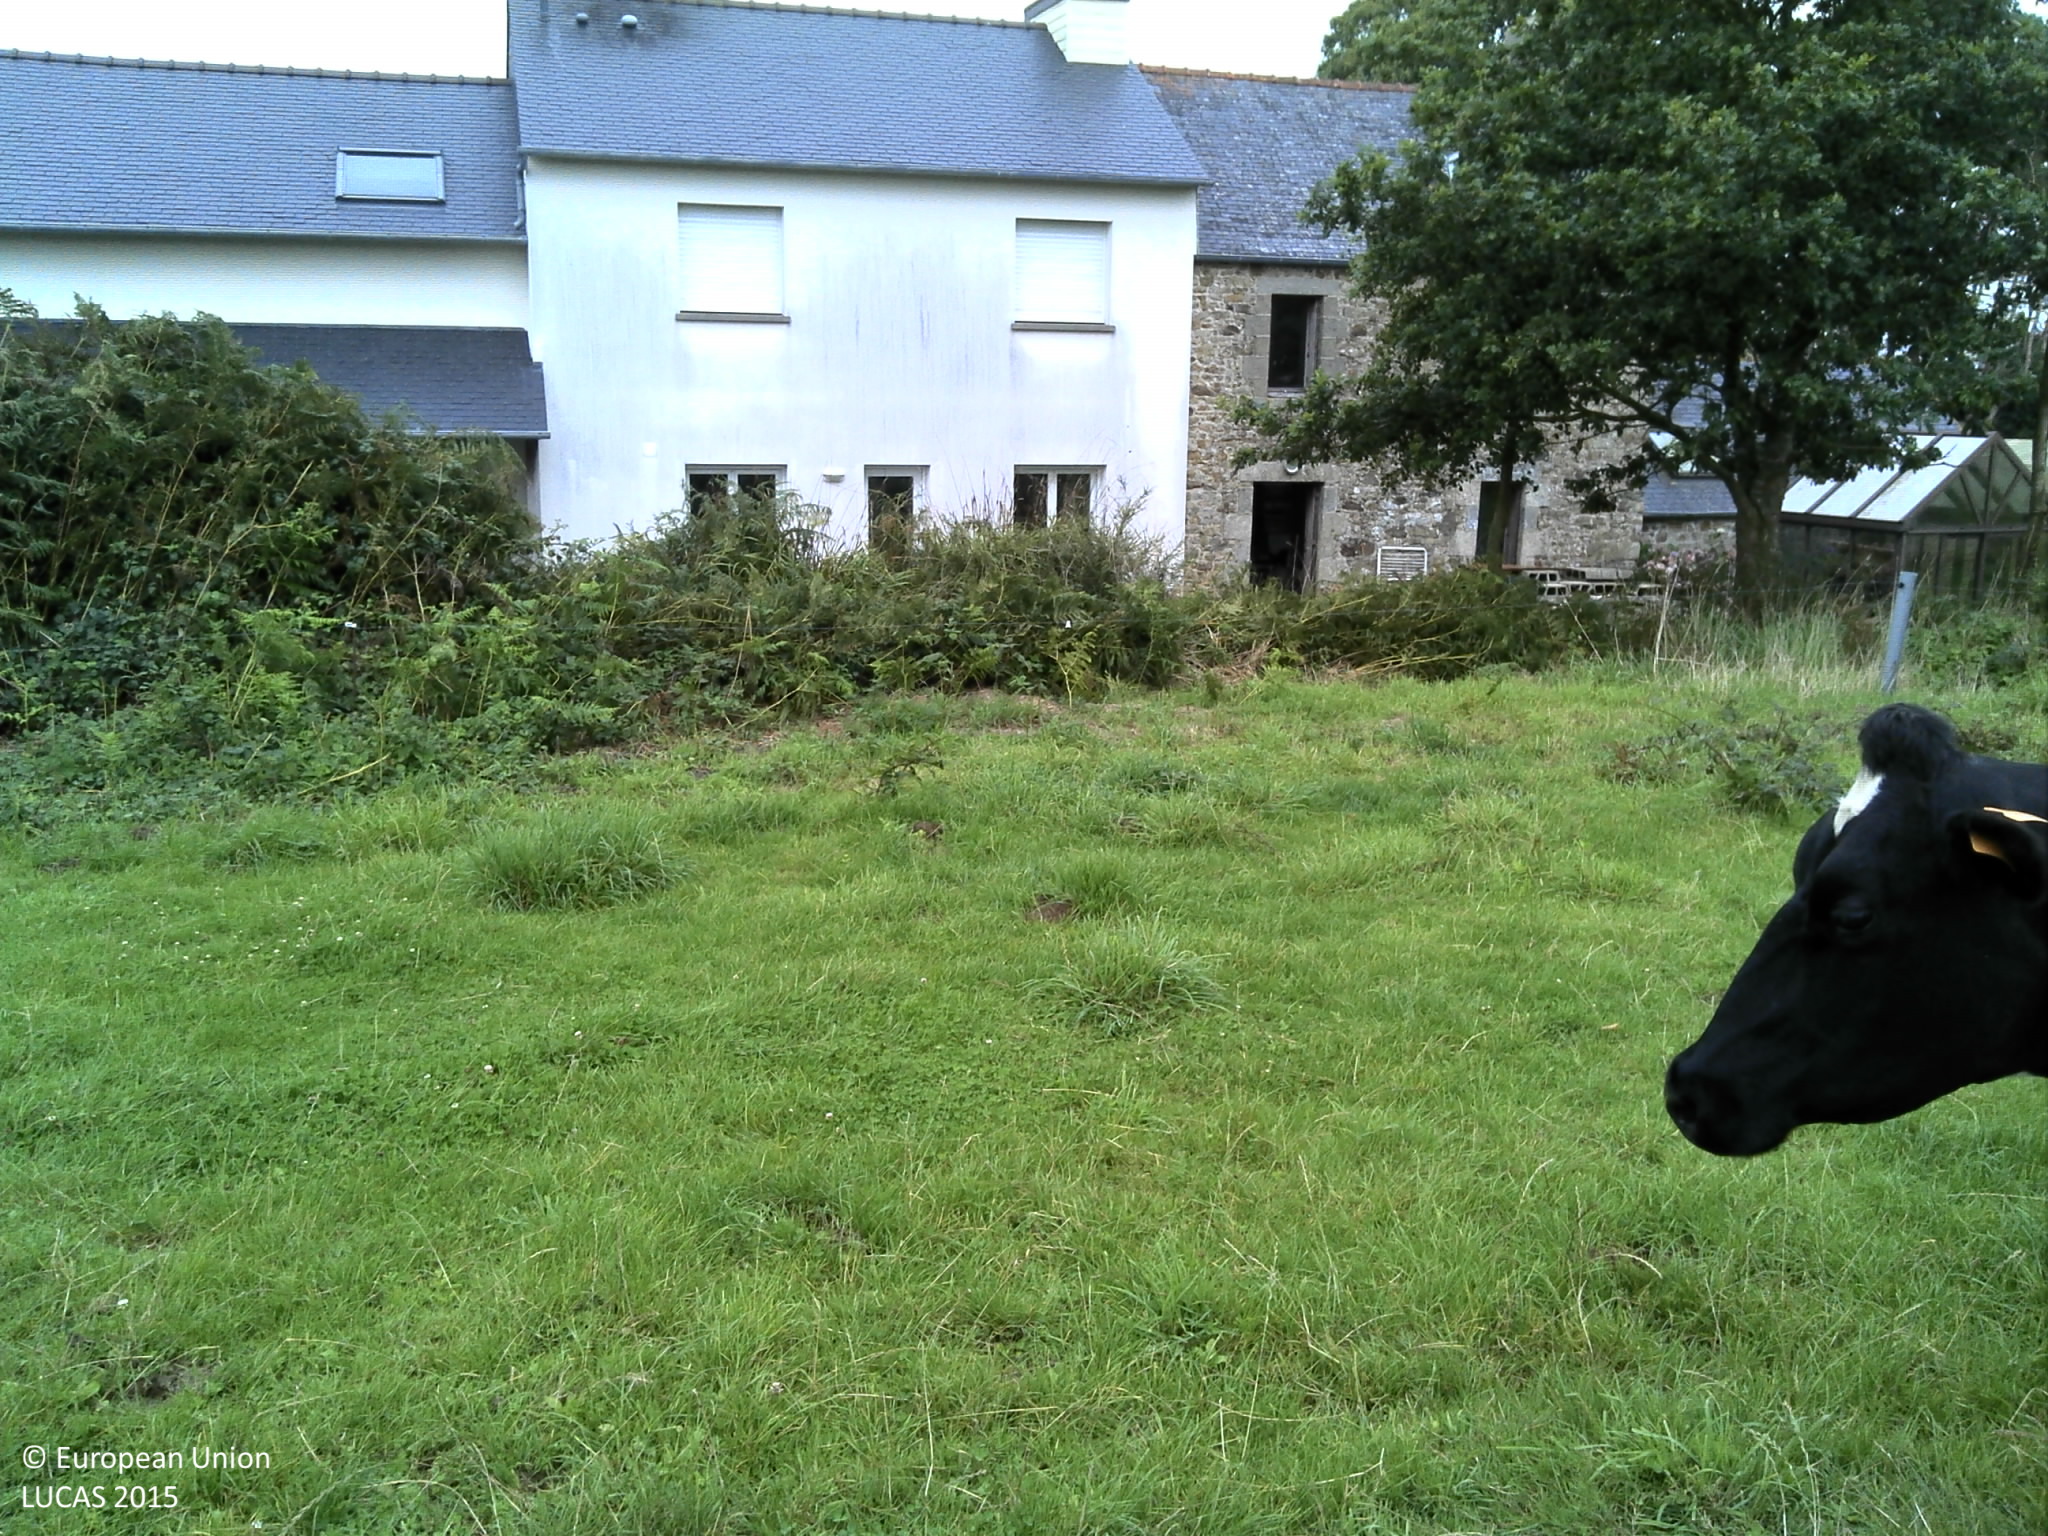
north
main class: Grassland
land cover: Grassland without tree/shrub cover
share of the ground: > 75 %
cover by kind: herbaceous plants 100 %
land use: Agriculture (excluding fallow land and kitchen gardens)
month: August
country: FR
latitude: 48.5488
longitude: -4.2780
